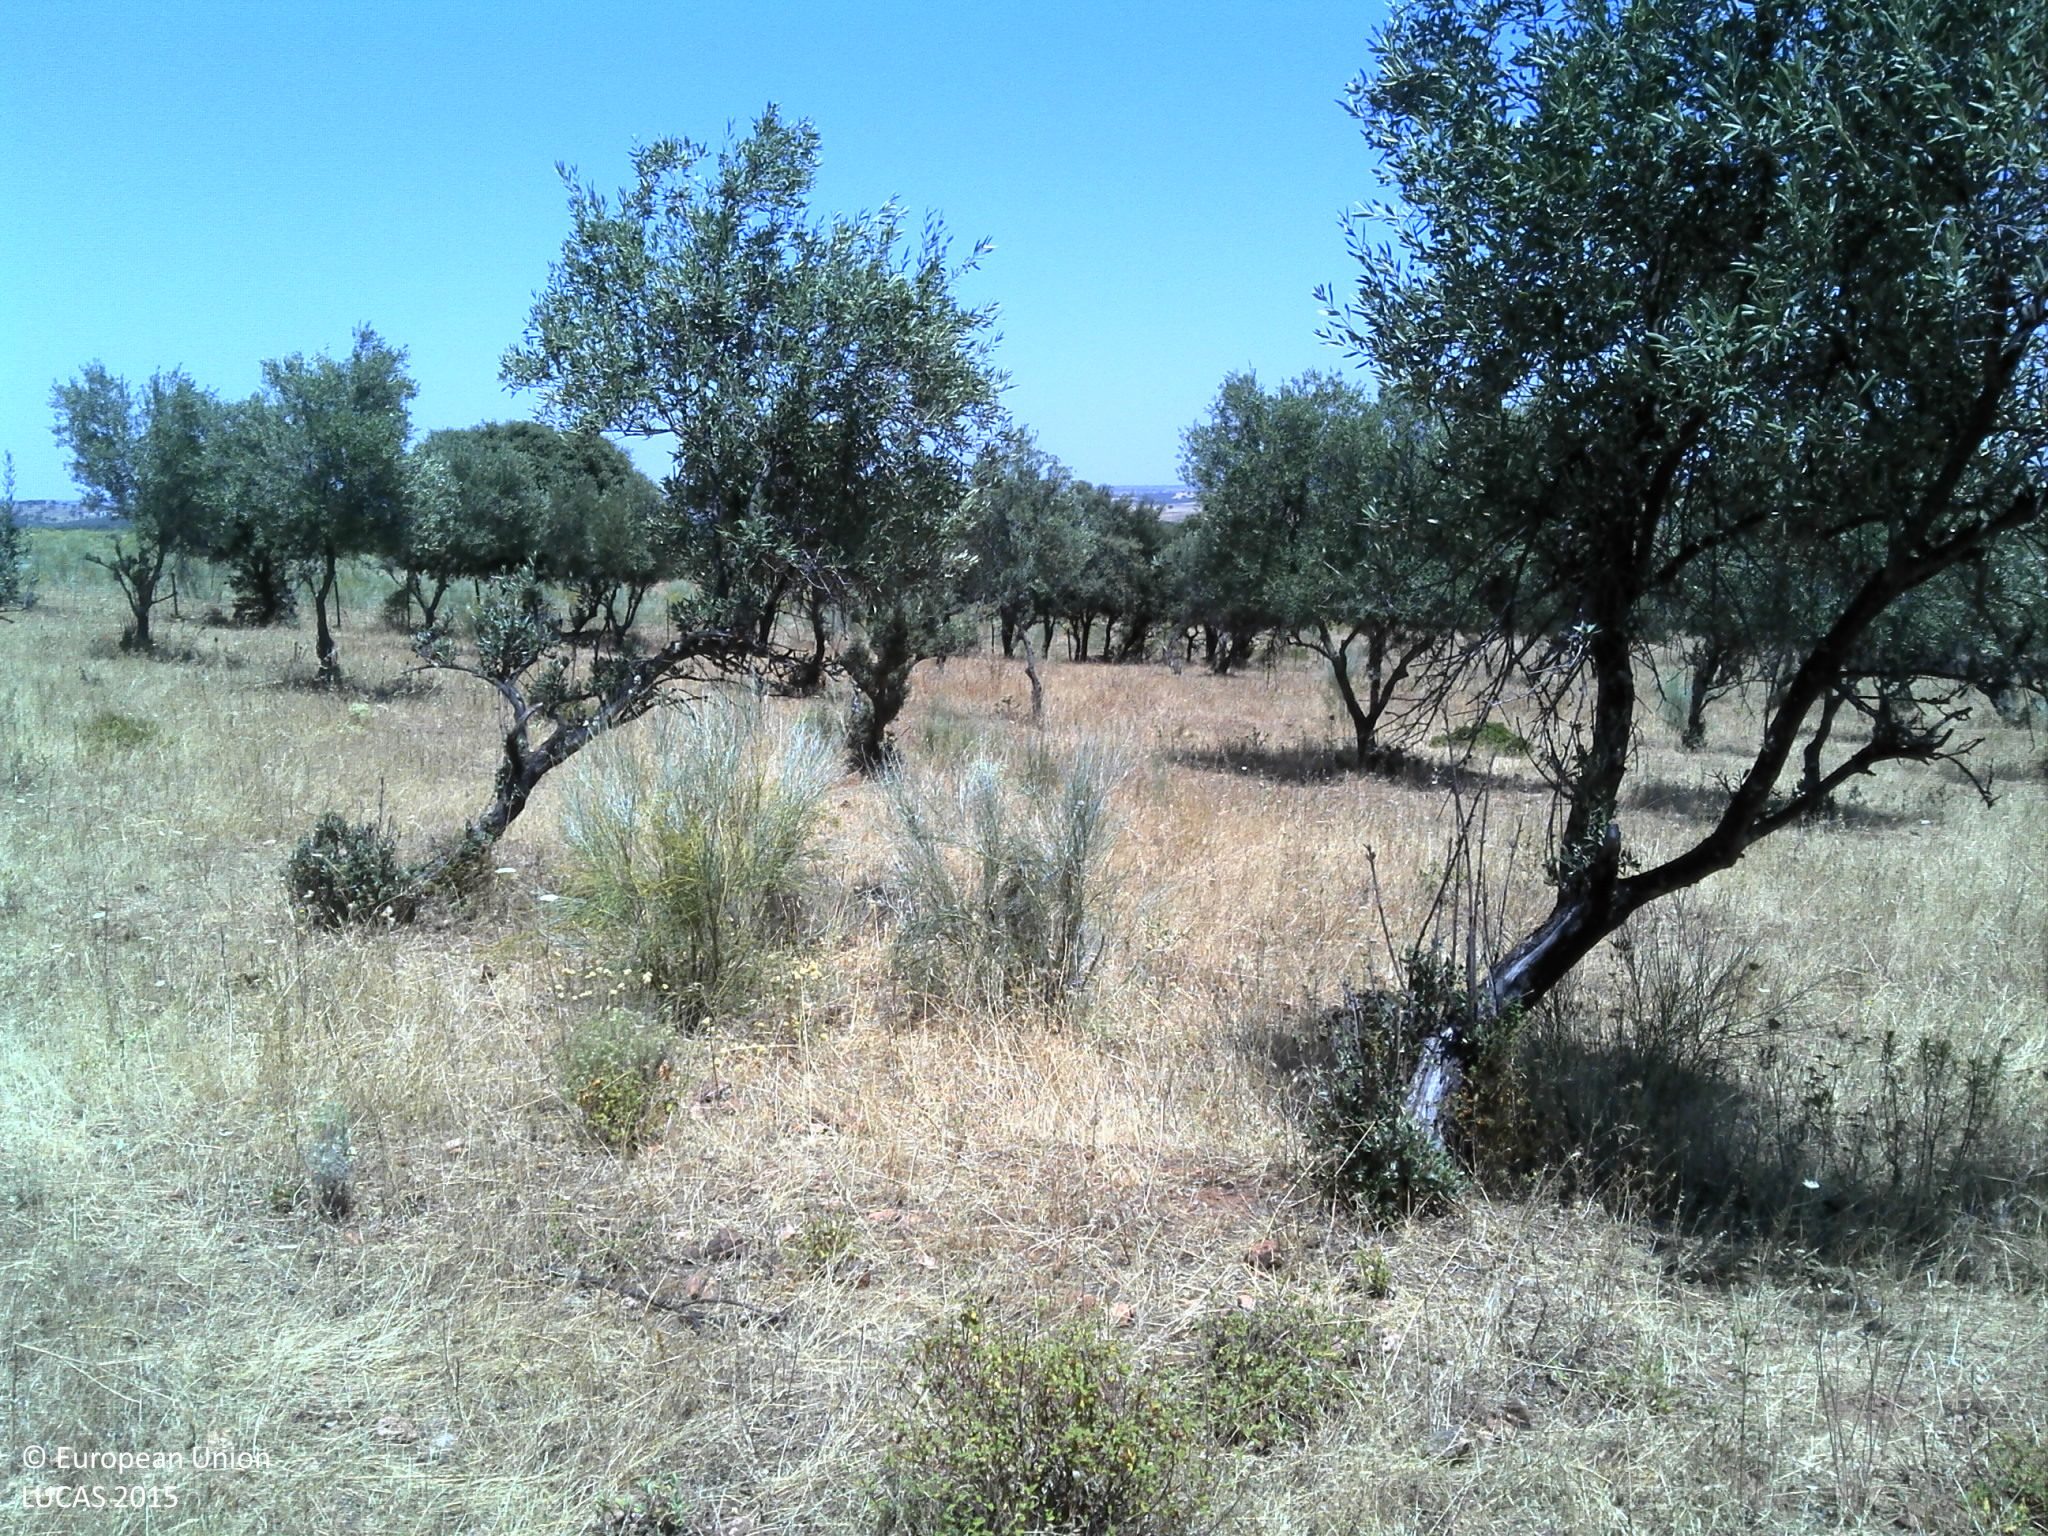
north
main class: Cropland
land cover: Olive groves
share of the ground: 25 - 50 %
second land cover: Grassland without tree/shrub cover
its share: 50 - 75 %
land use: Agriculture (excluding fallow land and kitchen gardens)
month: June
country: PT
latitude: 38.0519
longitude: -7.3036
